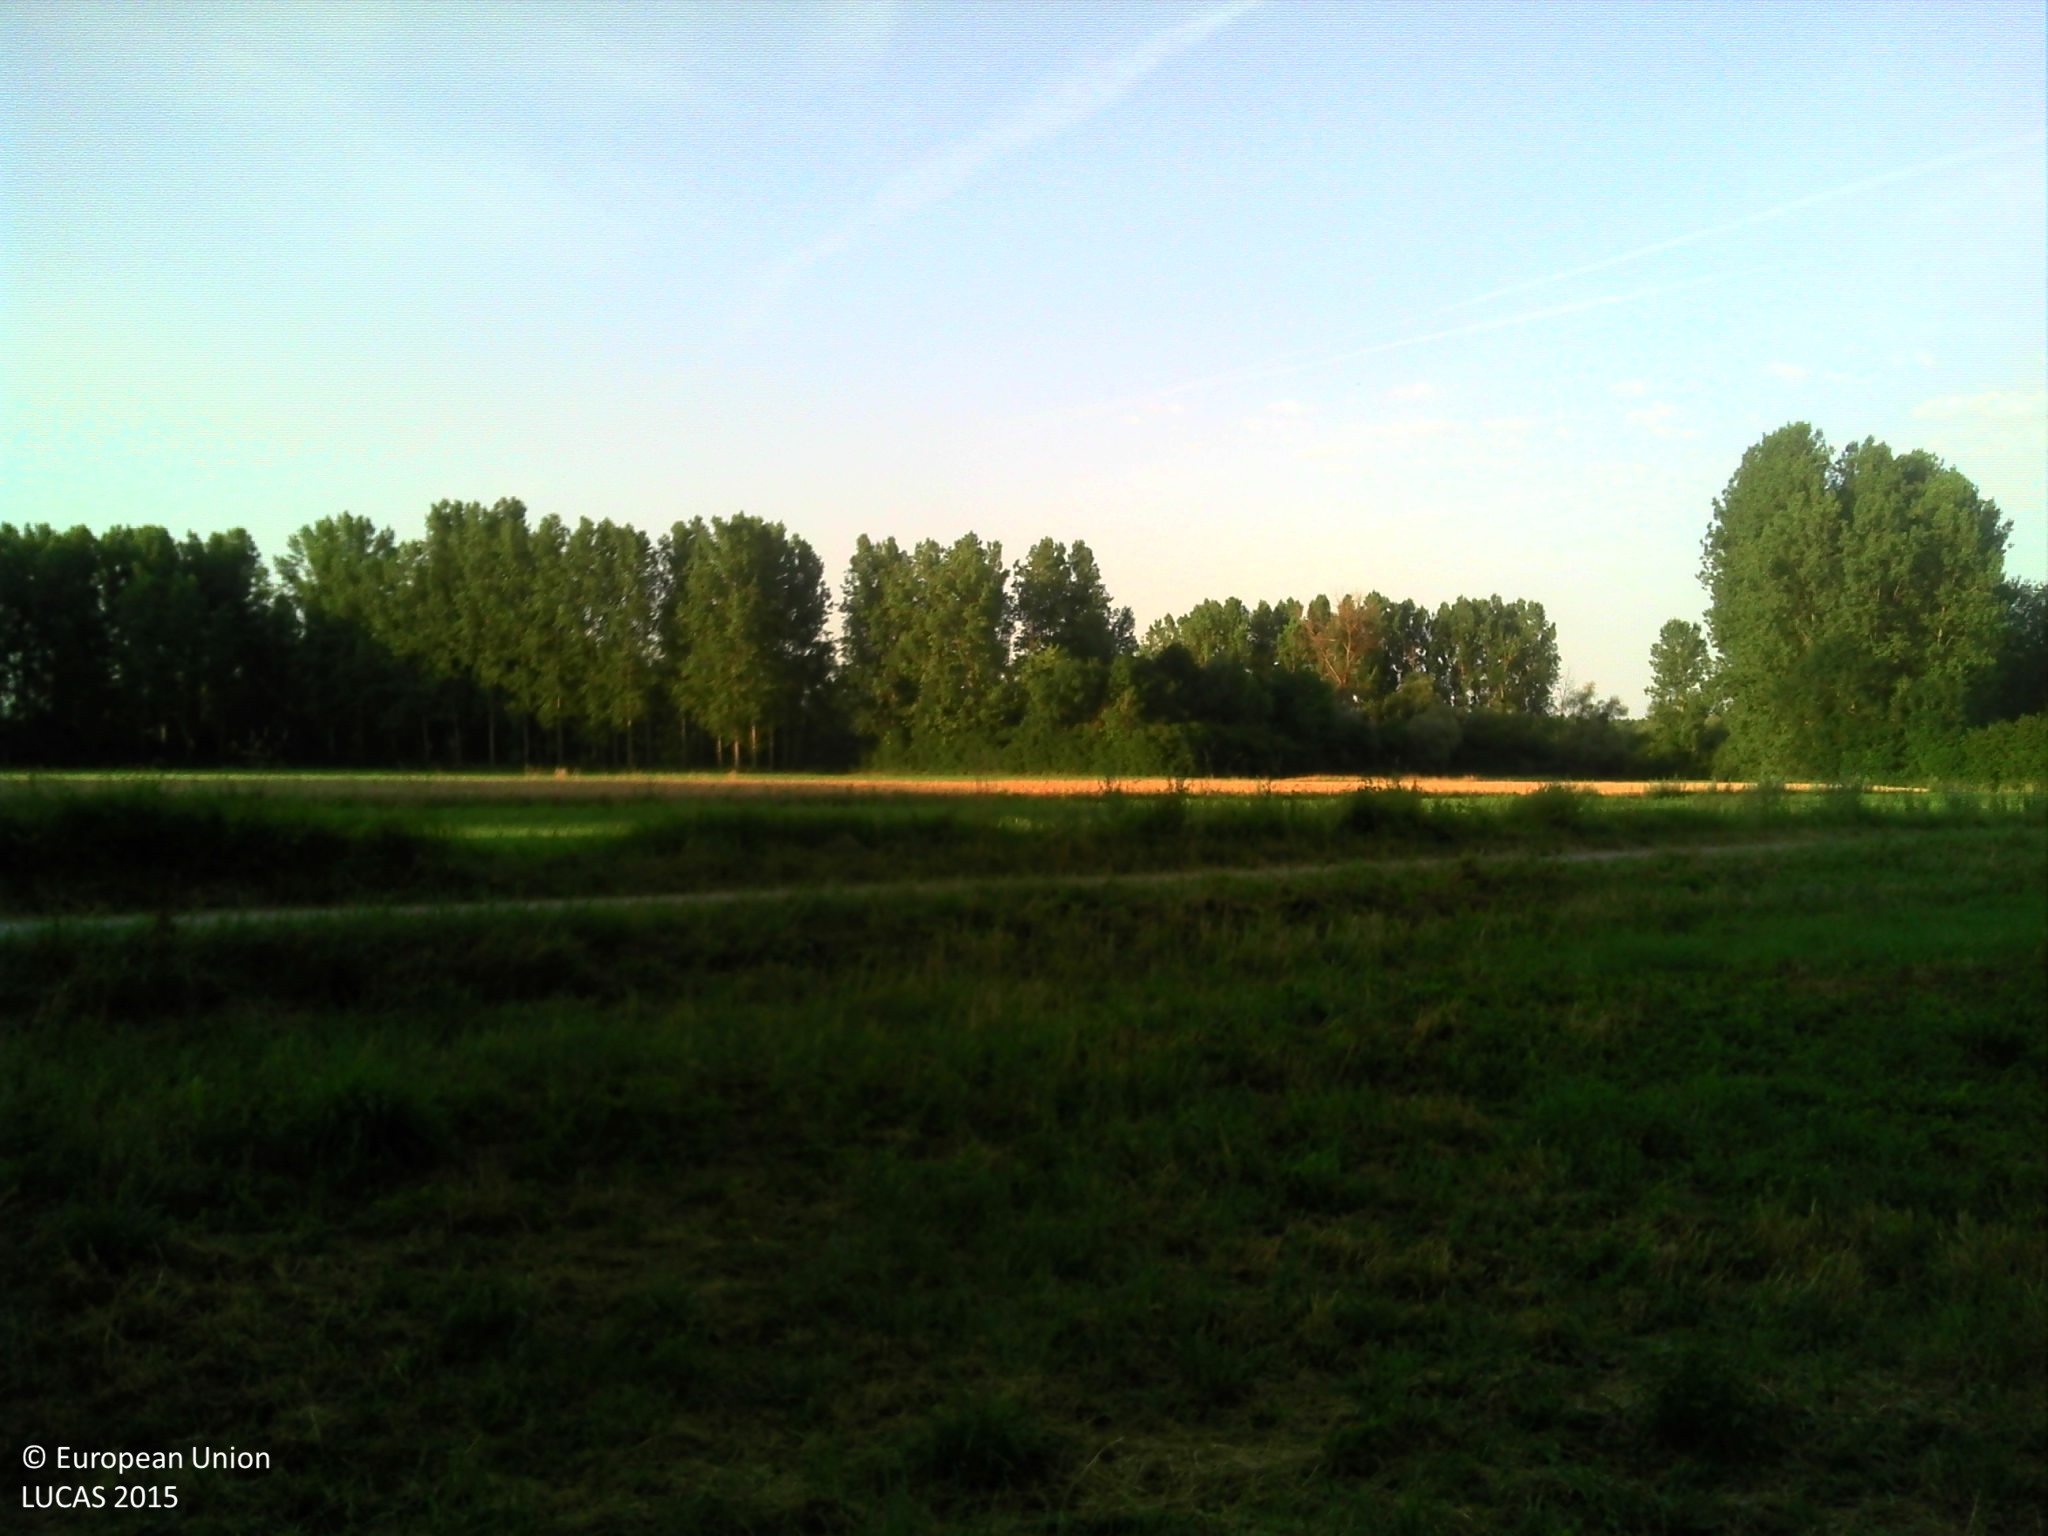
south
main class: Grassland
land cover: Grassland without tree/shrub cover
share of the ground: > 75 %
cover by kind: herbaceous plants 100 %
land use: Agriculture (excluding fallow land and kitchen gardens)
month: July
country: FR
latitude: 46.9305
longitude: 5.2338
